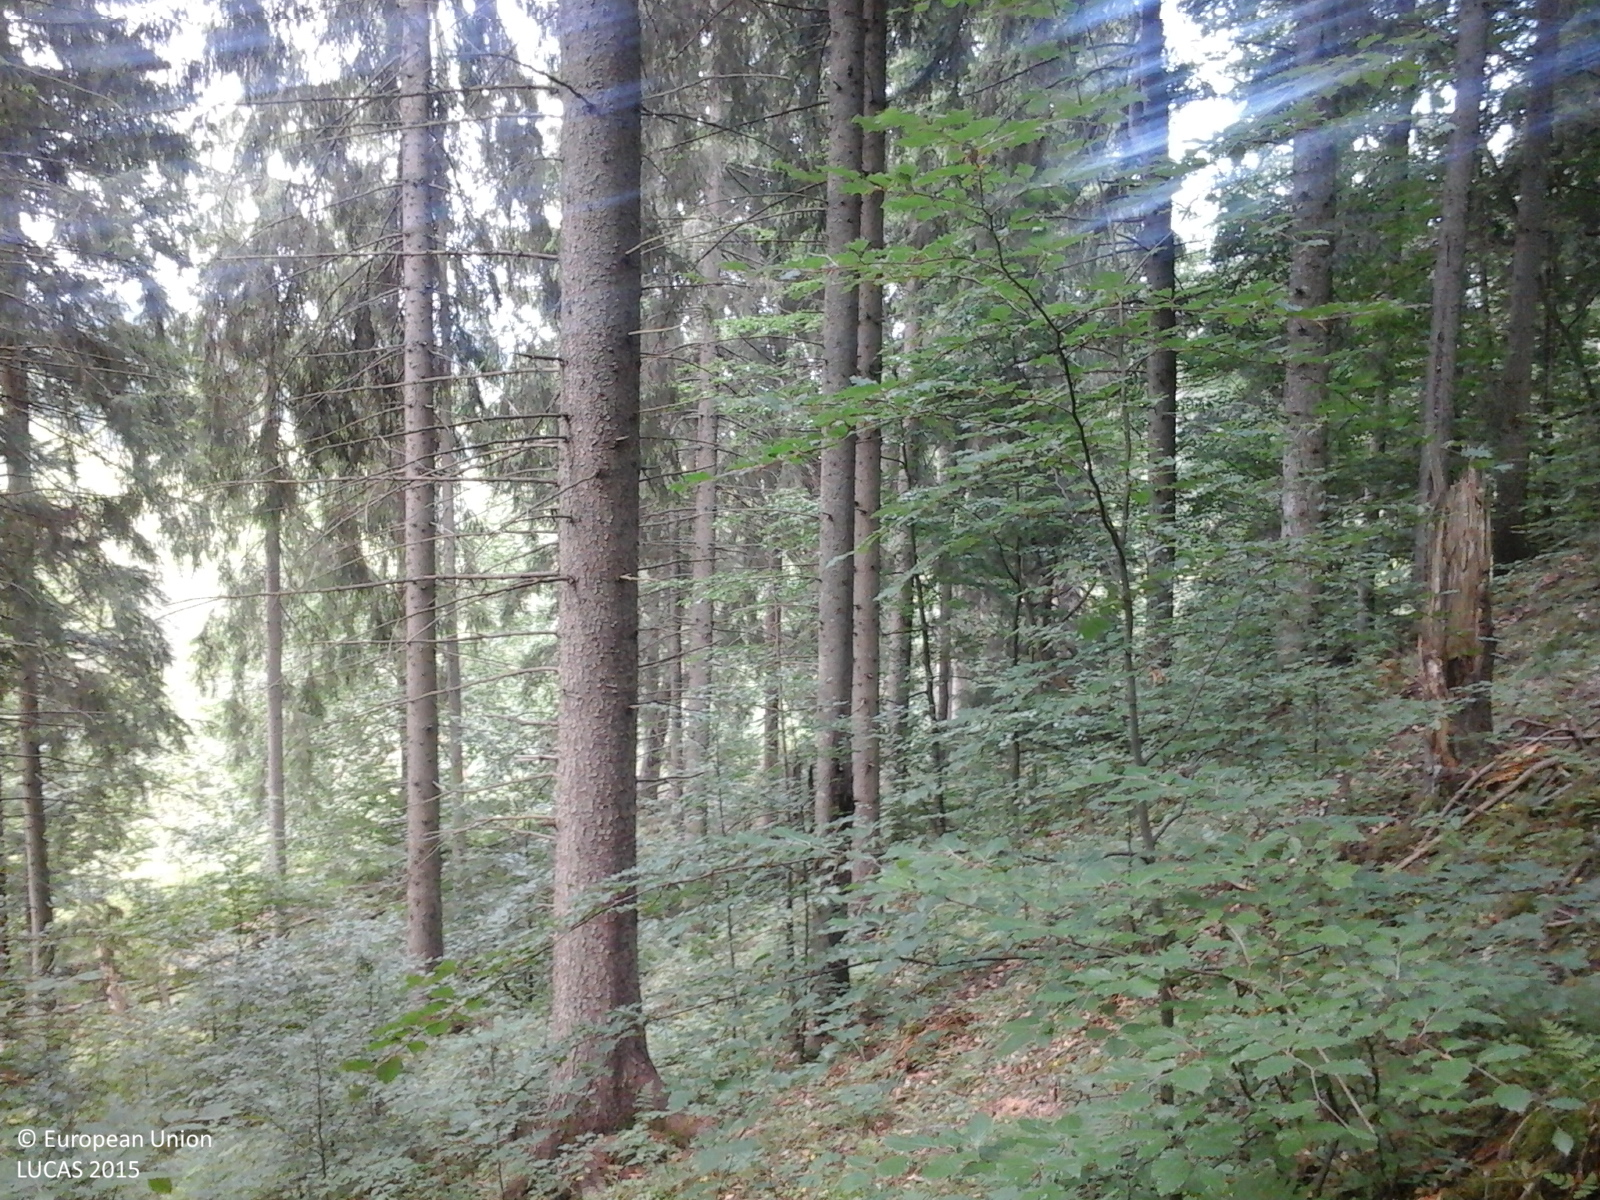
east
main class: Woodland
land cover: Other mixed woodland
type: alpine coniferous forest
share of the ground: > 75 %
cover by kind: coniferous forest trees 70 %, broadleaved forest trees 30 %
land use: Forestry
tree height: > 5 m
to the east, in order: Other mixed woodland; Fences; Other mixed woodland; Grassland without tree/shrub cover
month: June
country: RO
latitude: 47.5742
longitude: 25.3886
